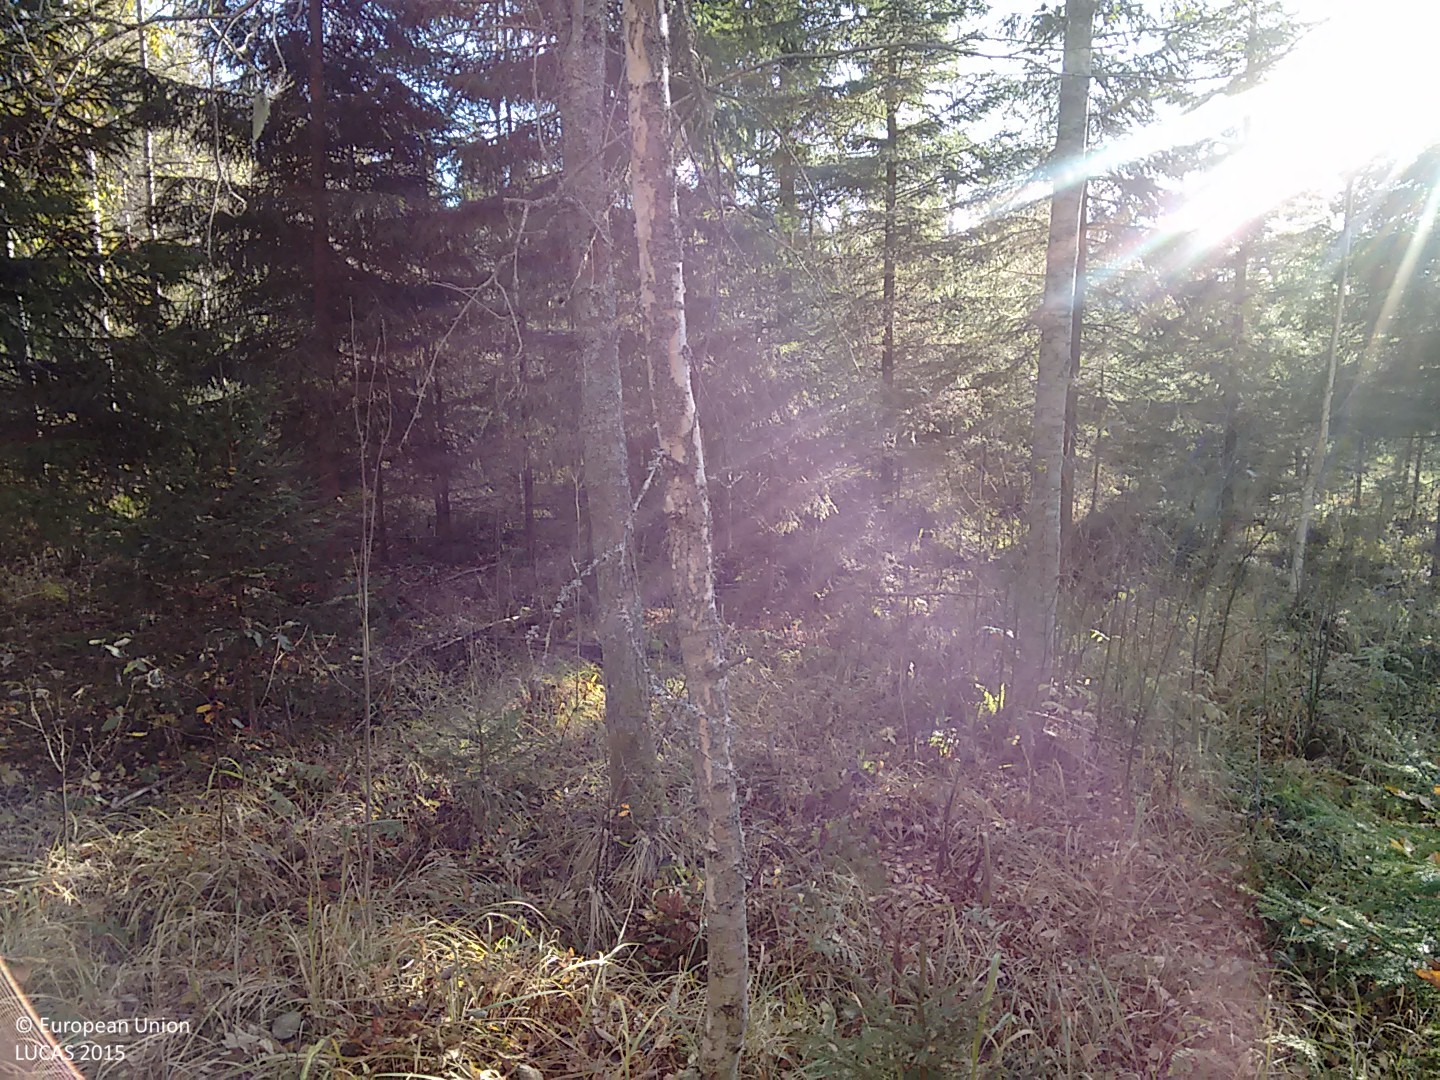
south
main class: Woodland
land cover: Spruce dominated mixed woodland
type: boreal forest
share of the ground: > 75 %
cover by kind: coniferous forest trees 45 %, broadleaved forest trees 40 %, shrubs 15 %
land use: Forestry
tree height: > 5 m
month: October
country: FI
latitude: 62.6495
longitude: 25.8640
